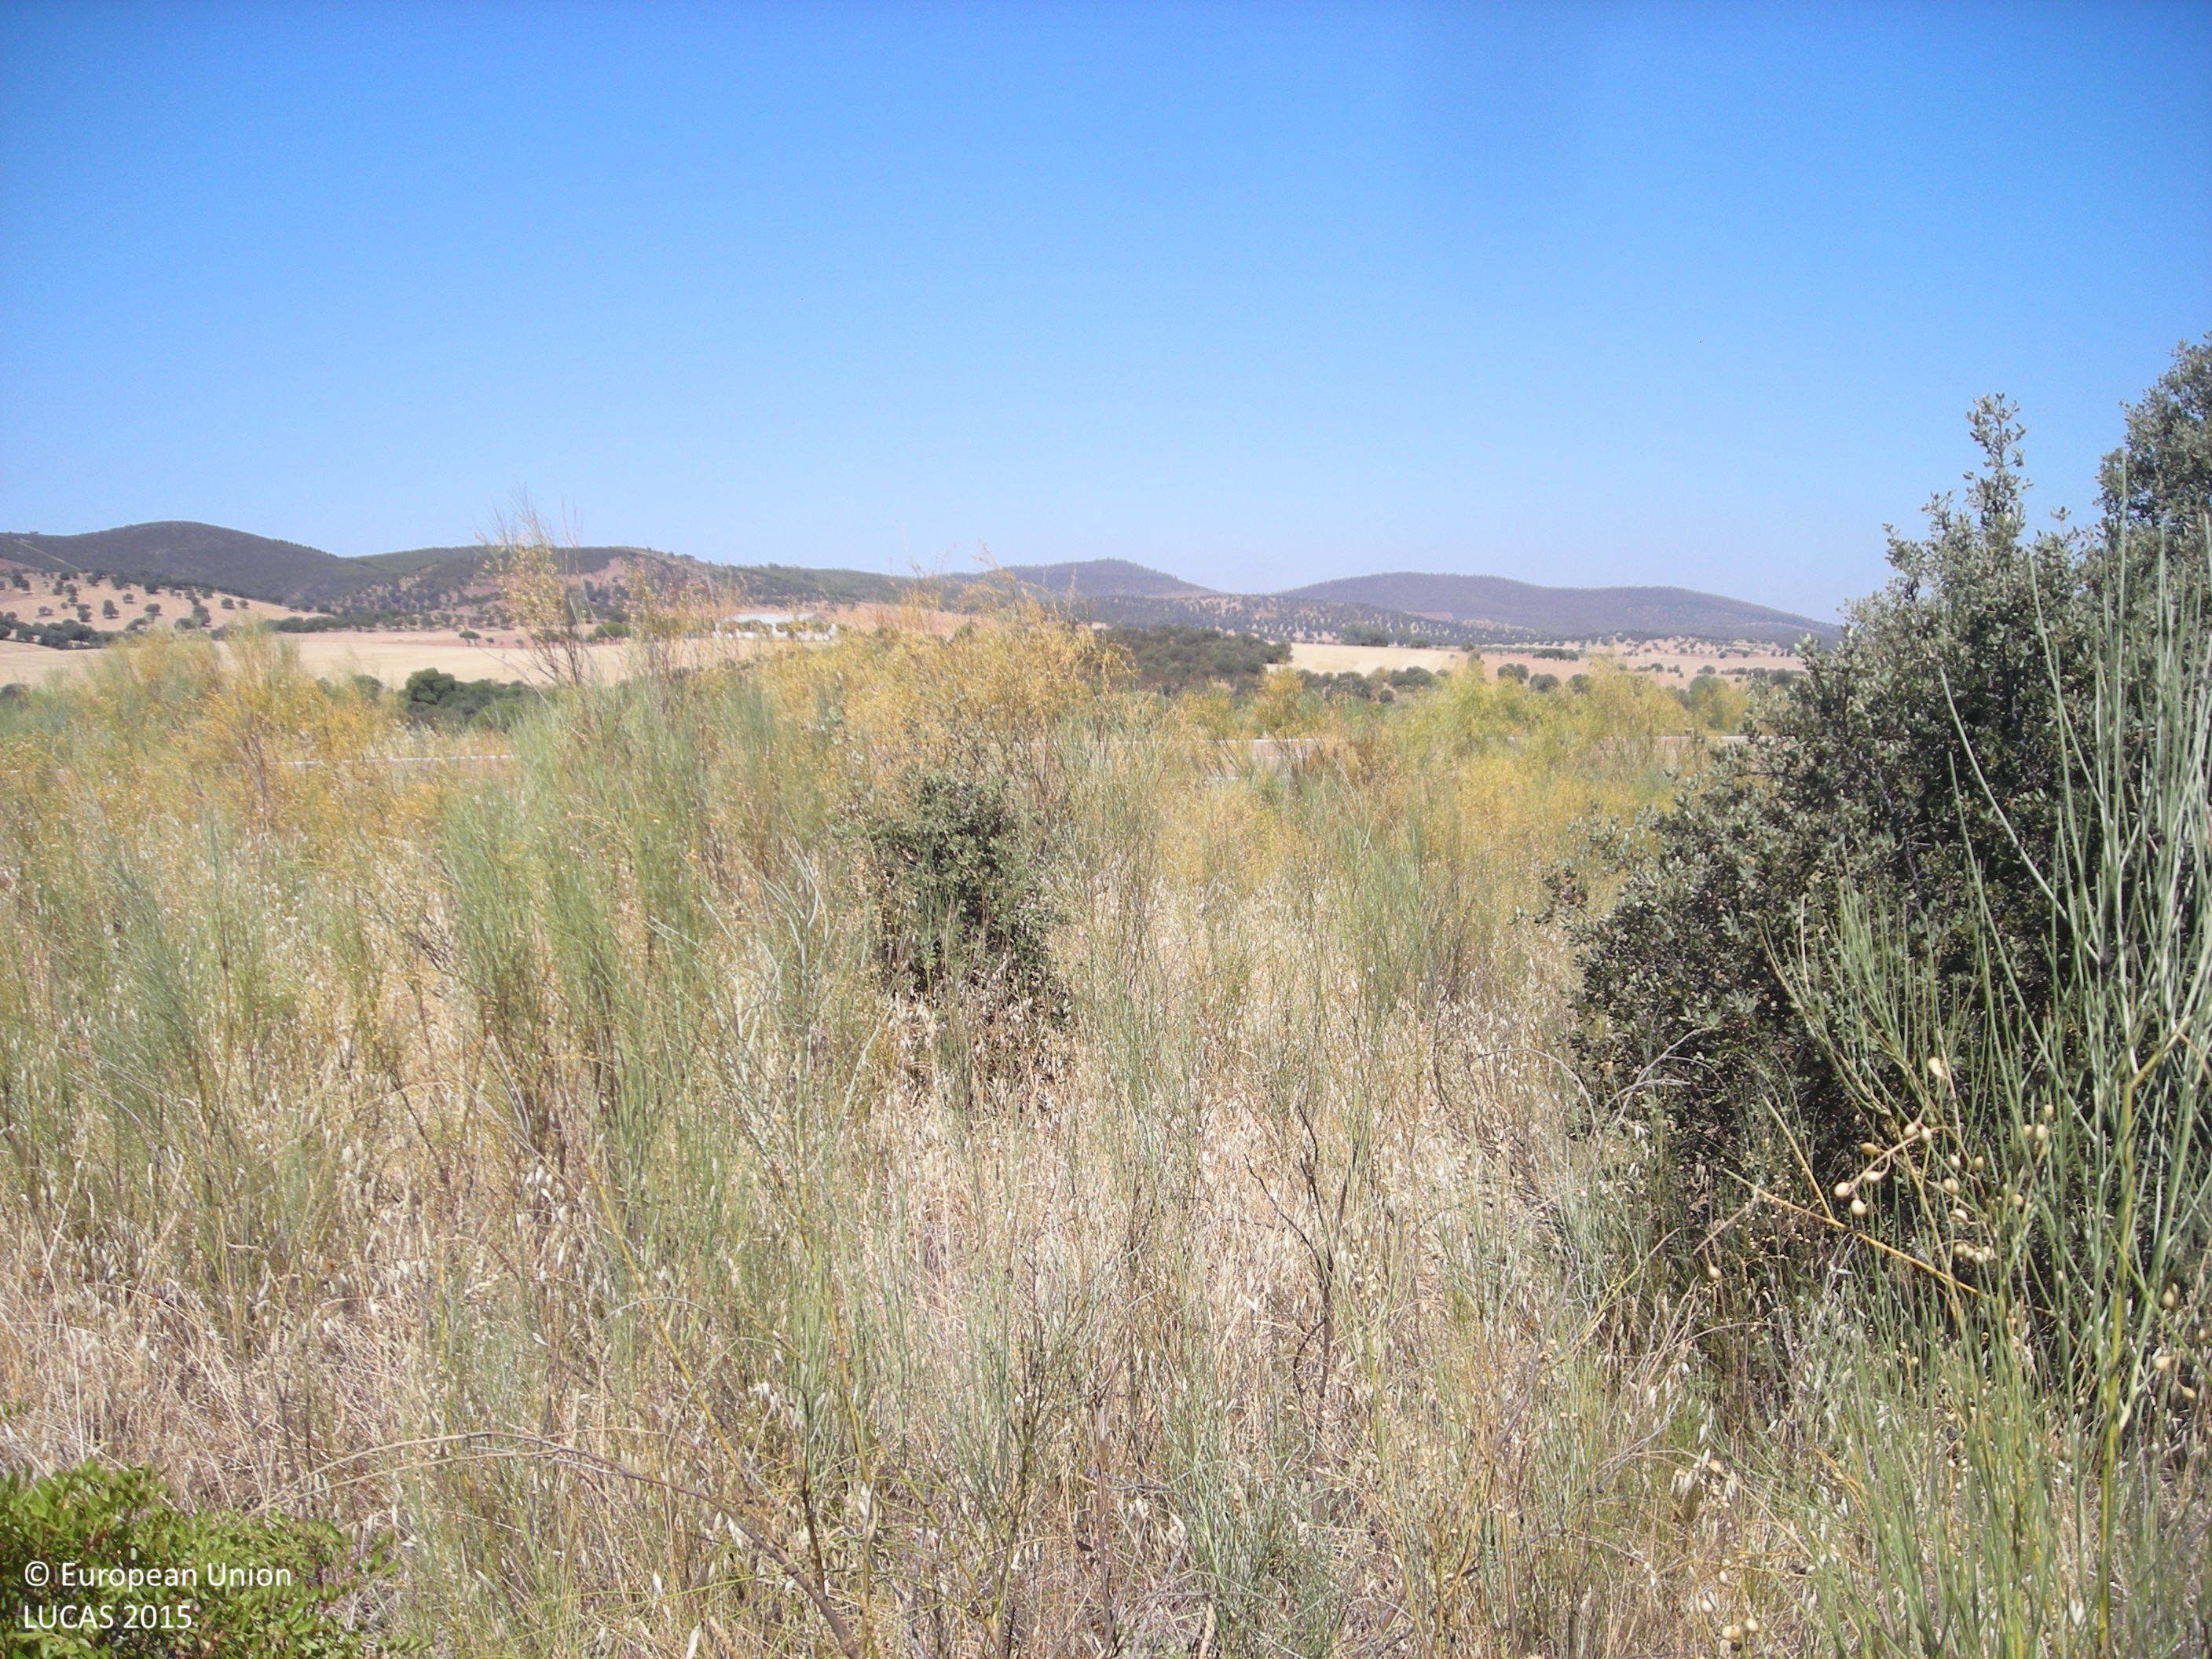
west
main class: Grassland
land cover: Grassland with sparse tree/shrub cover
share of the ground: > 75 %
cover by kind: herbaceous plants 85 %, shrubs 10 %, broadleaved forest trees 5 %
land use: Agriculture (excluding fallow land and kitchen gardens)
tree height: > 5 m
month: July
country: ES
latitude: 38.7954
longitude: -5.9016
